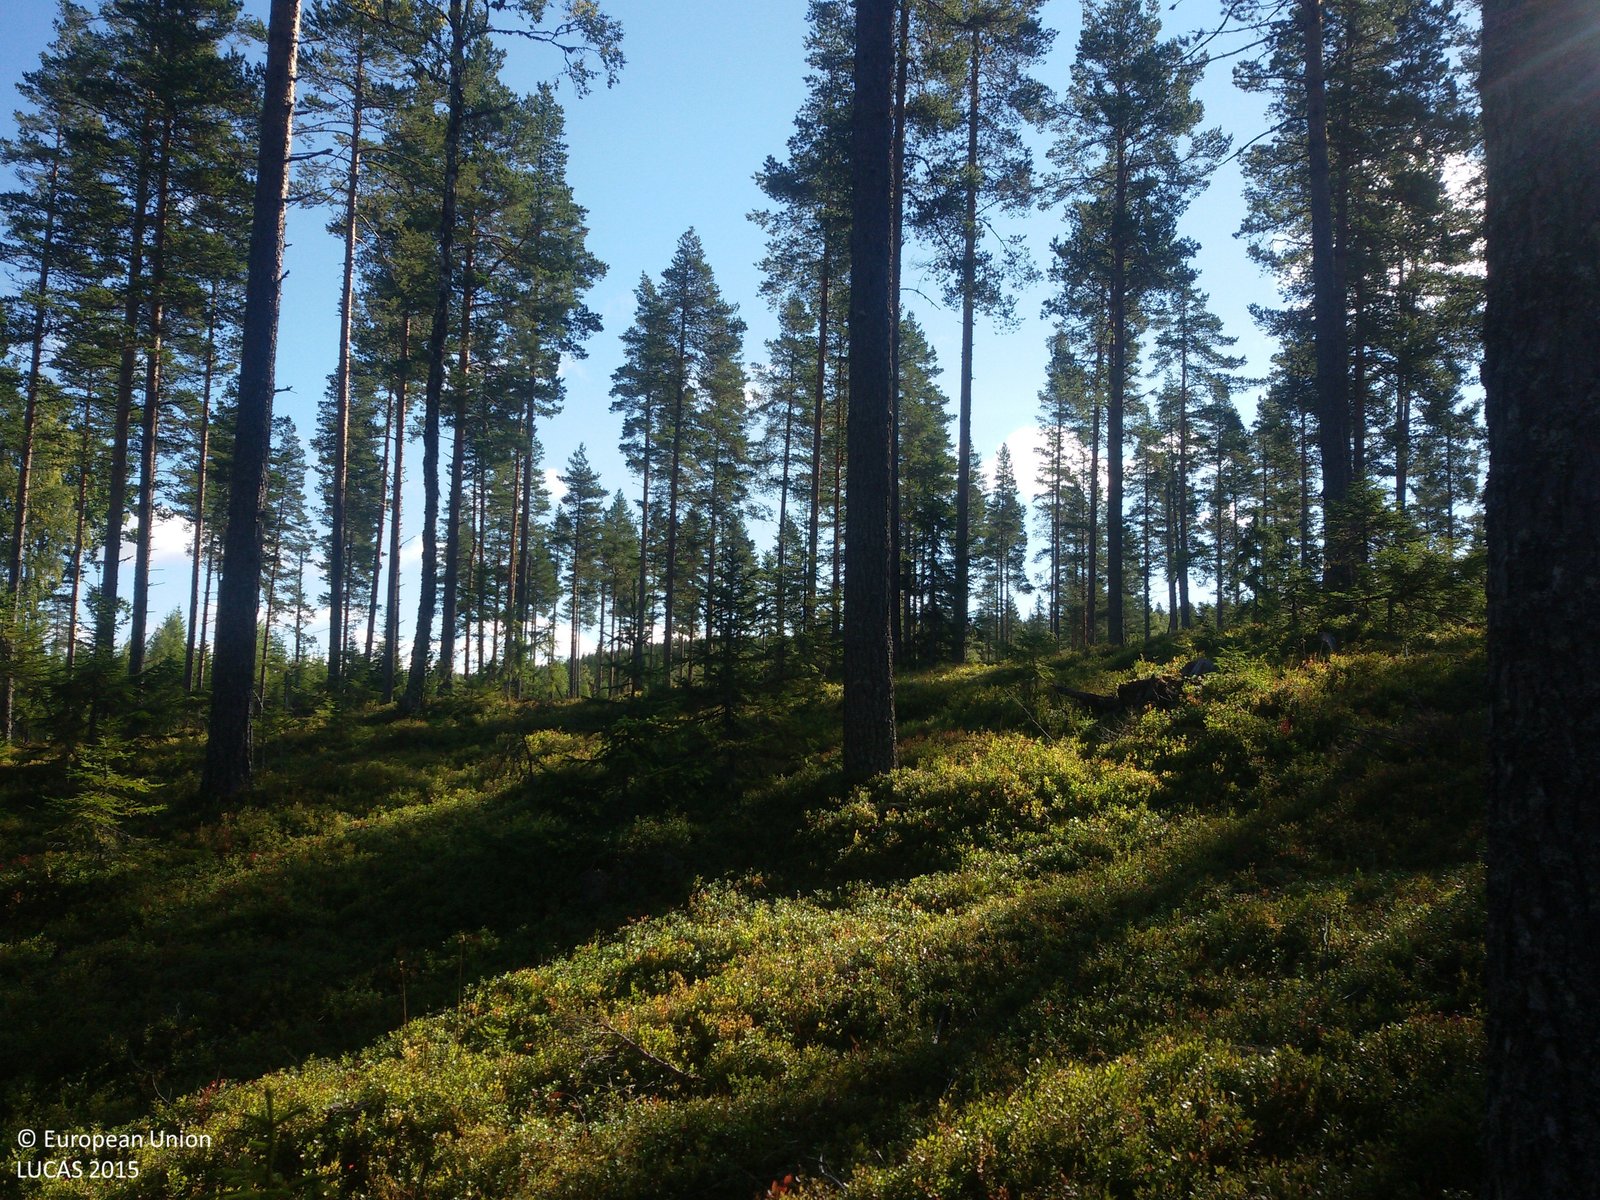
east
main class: Woodland
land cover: Pine dominated coniferous woodland
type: boreal forest
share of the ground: 25 - 50 %
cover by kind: shrubs 50 %, coniferous forest trees 40 %, lichens and mosses 10 %
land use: Forestry
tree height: > 5 m
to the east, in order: Pine dominated coniferous woodland; Paved roads, cycling and walking lanes; Pine dominated mixed woodland; Spruce dominated mixed woodland
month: September
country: SE
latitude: 60.8736
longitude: 15.3460
